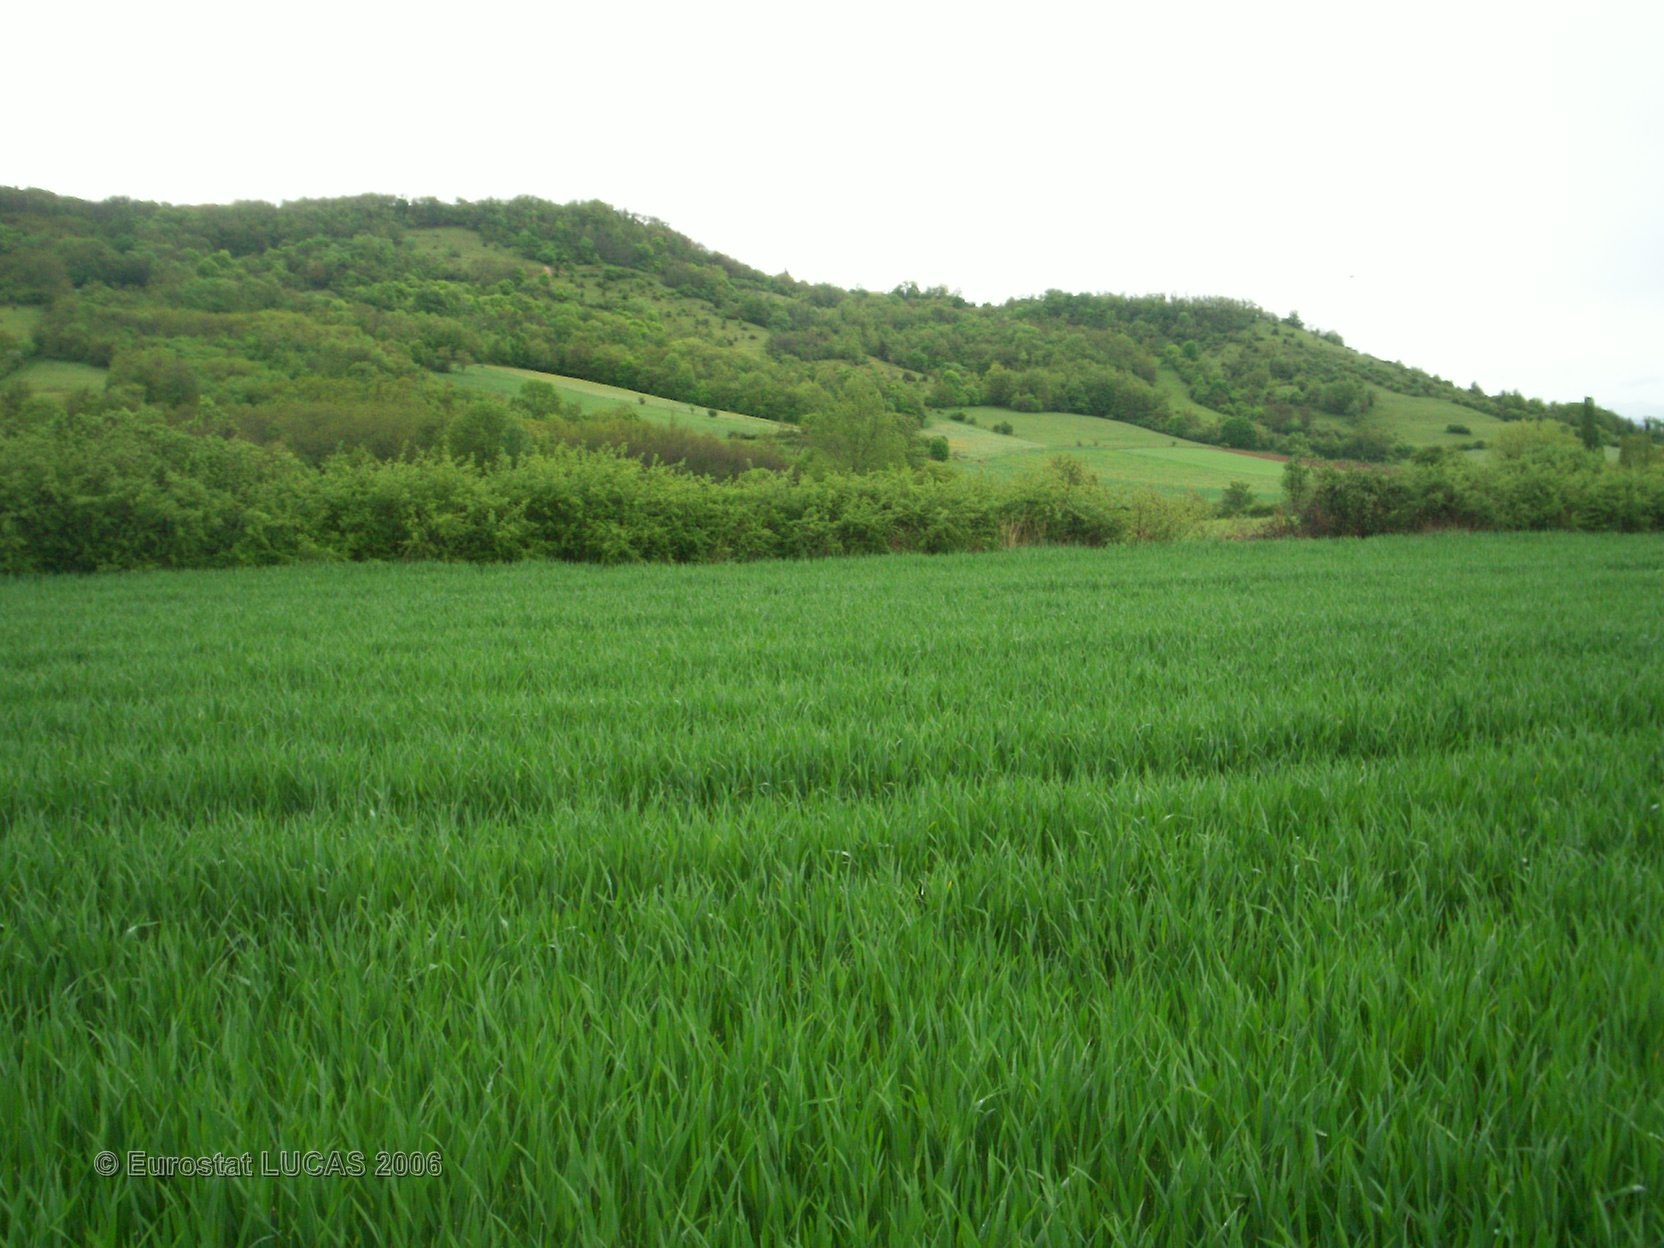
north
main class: Cropland
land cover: Common wheat
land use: Agriculture (excluding fallow land and kitchen gardens)
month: May
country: FR
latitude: 45.4143
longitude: 3.2417
